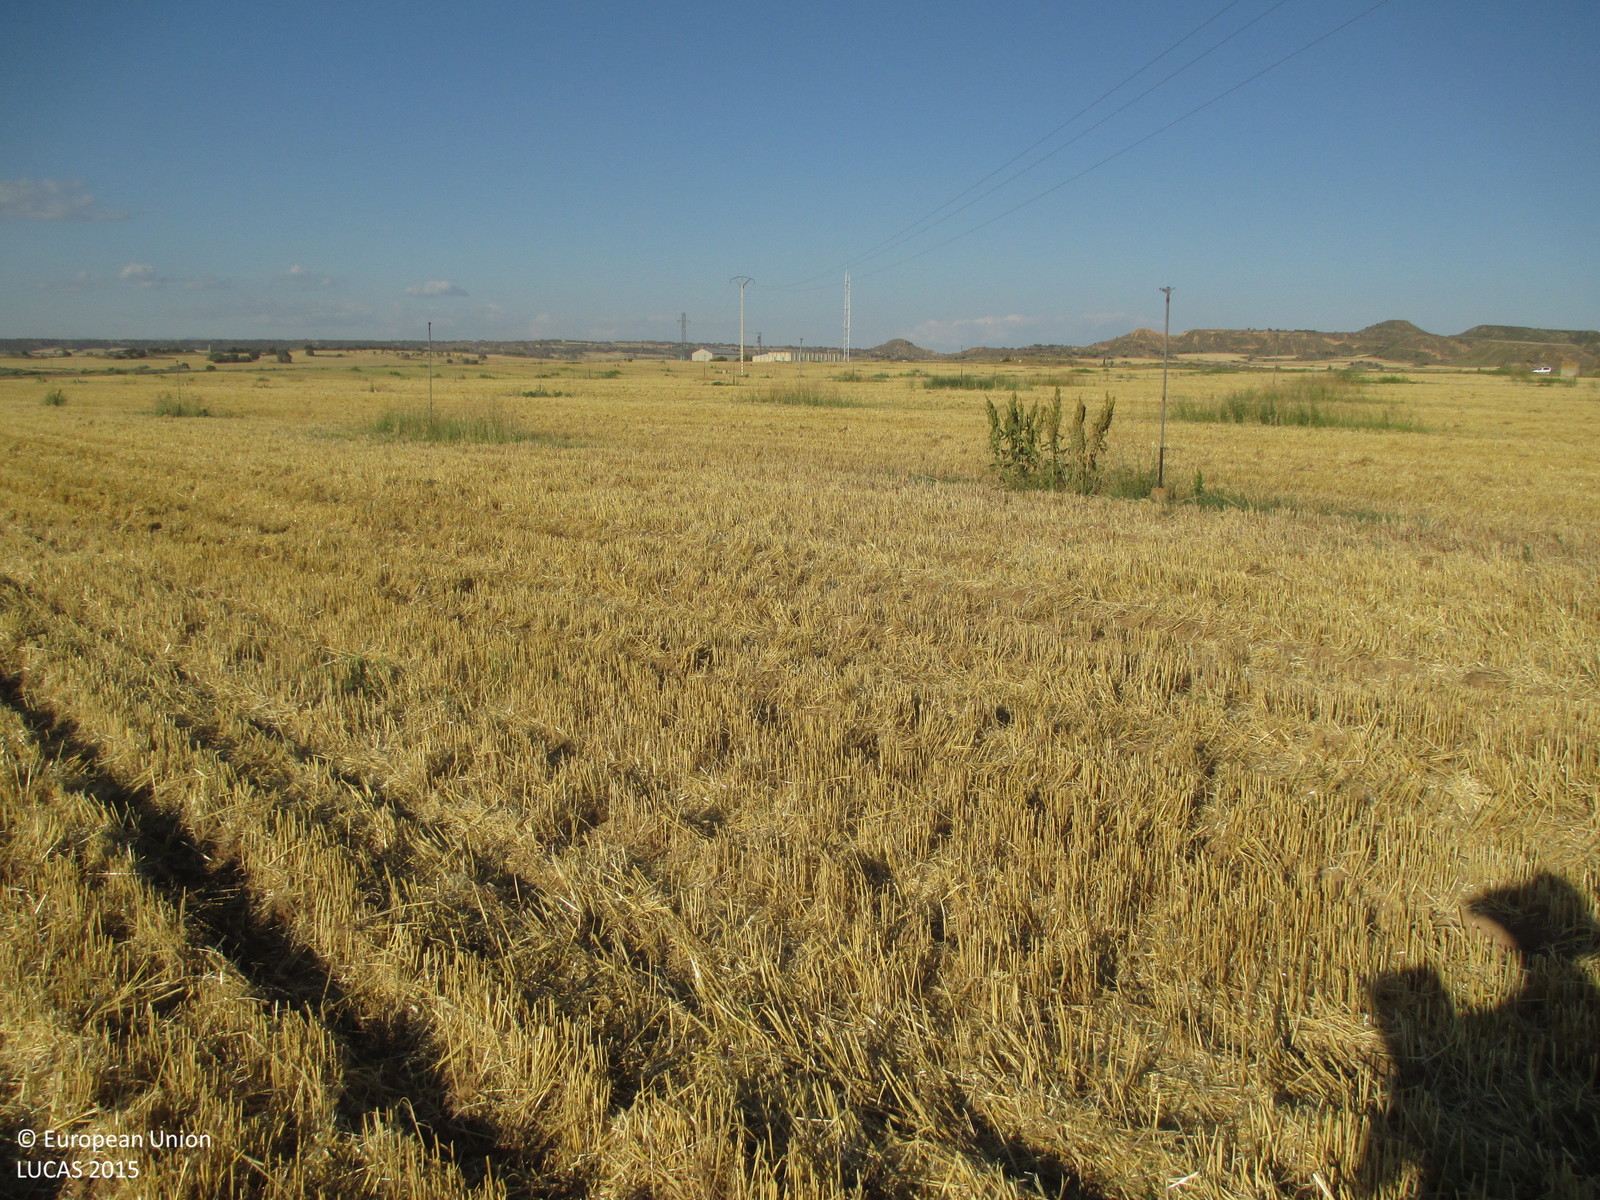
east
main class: Cropland
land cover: Sunflower
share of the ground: < 10 %
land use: Agriculture (excluding fallow land and kitchen gardens)
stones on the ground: < 10 %
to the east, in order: Sunflower; Electric lines; Sunflower
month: June
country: ES
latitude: 42.0291
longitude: -0.3725
